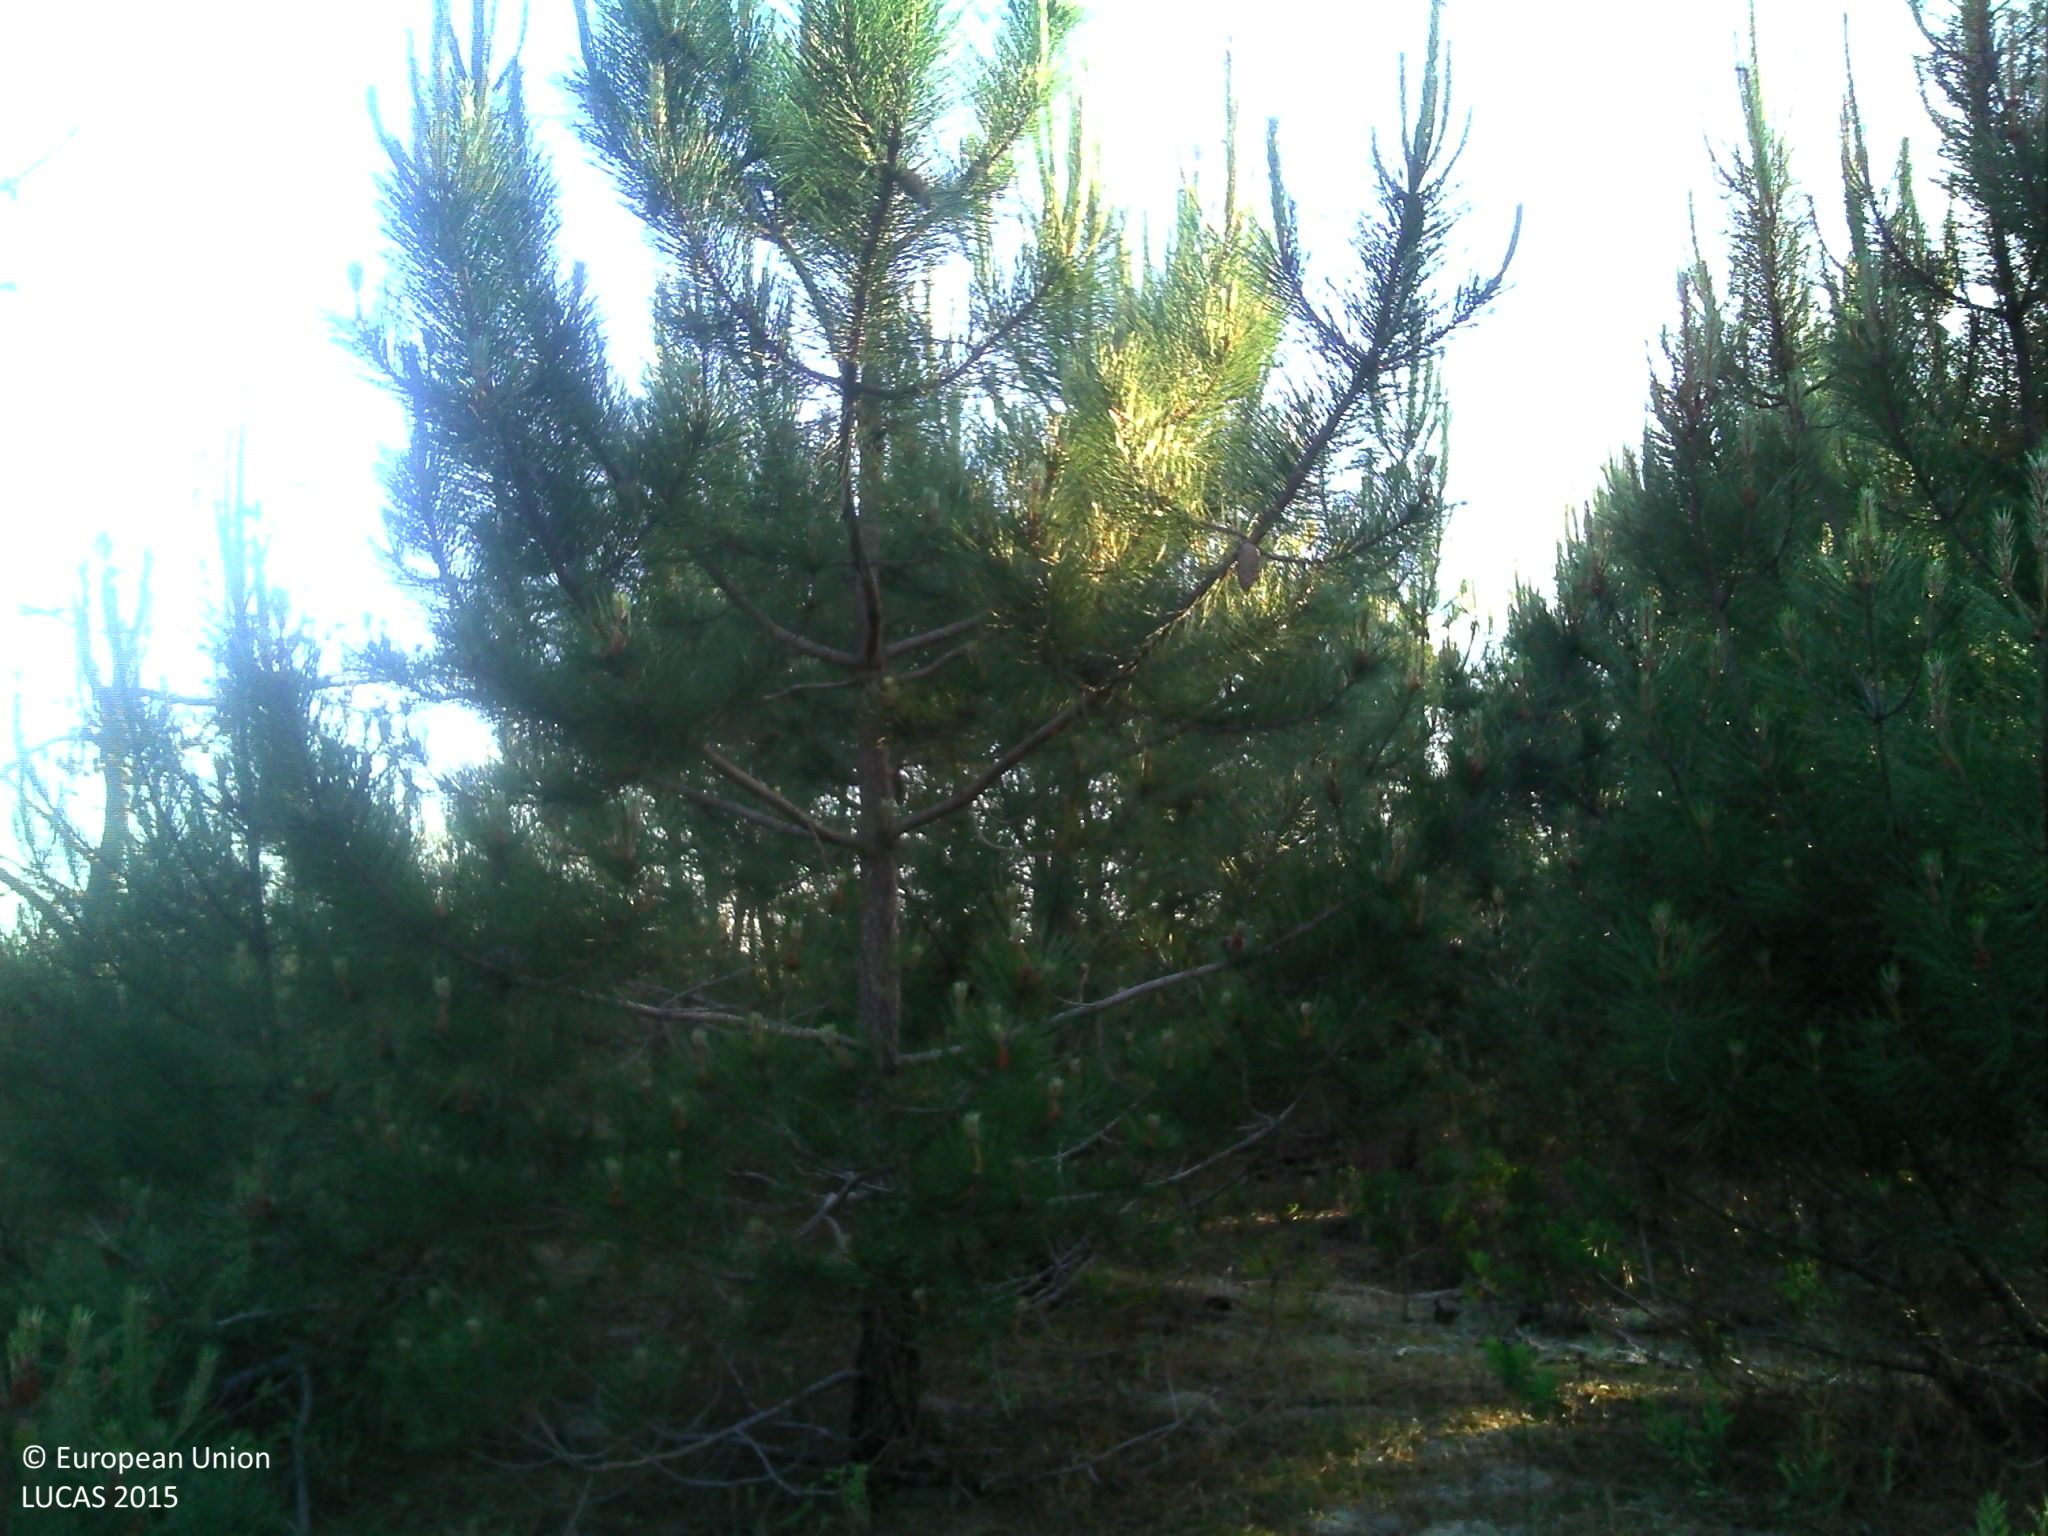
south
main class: Woodland
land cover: Pine dominated coniferous woodland
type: coniferous forest of the mediterranean region
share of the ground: > 75 %
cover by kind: coniferous forest trees 75 %, herbaceous plants 25 %
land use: Semi-natural and natural areas not in use
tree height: > 5 m
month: May
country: FR
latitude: 45.8469
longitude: -1.2471
